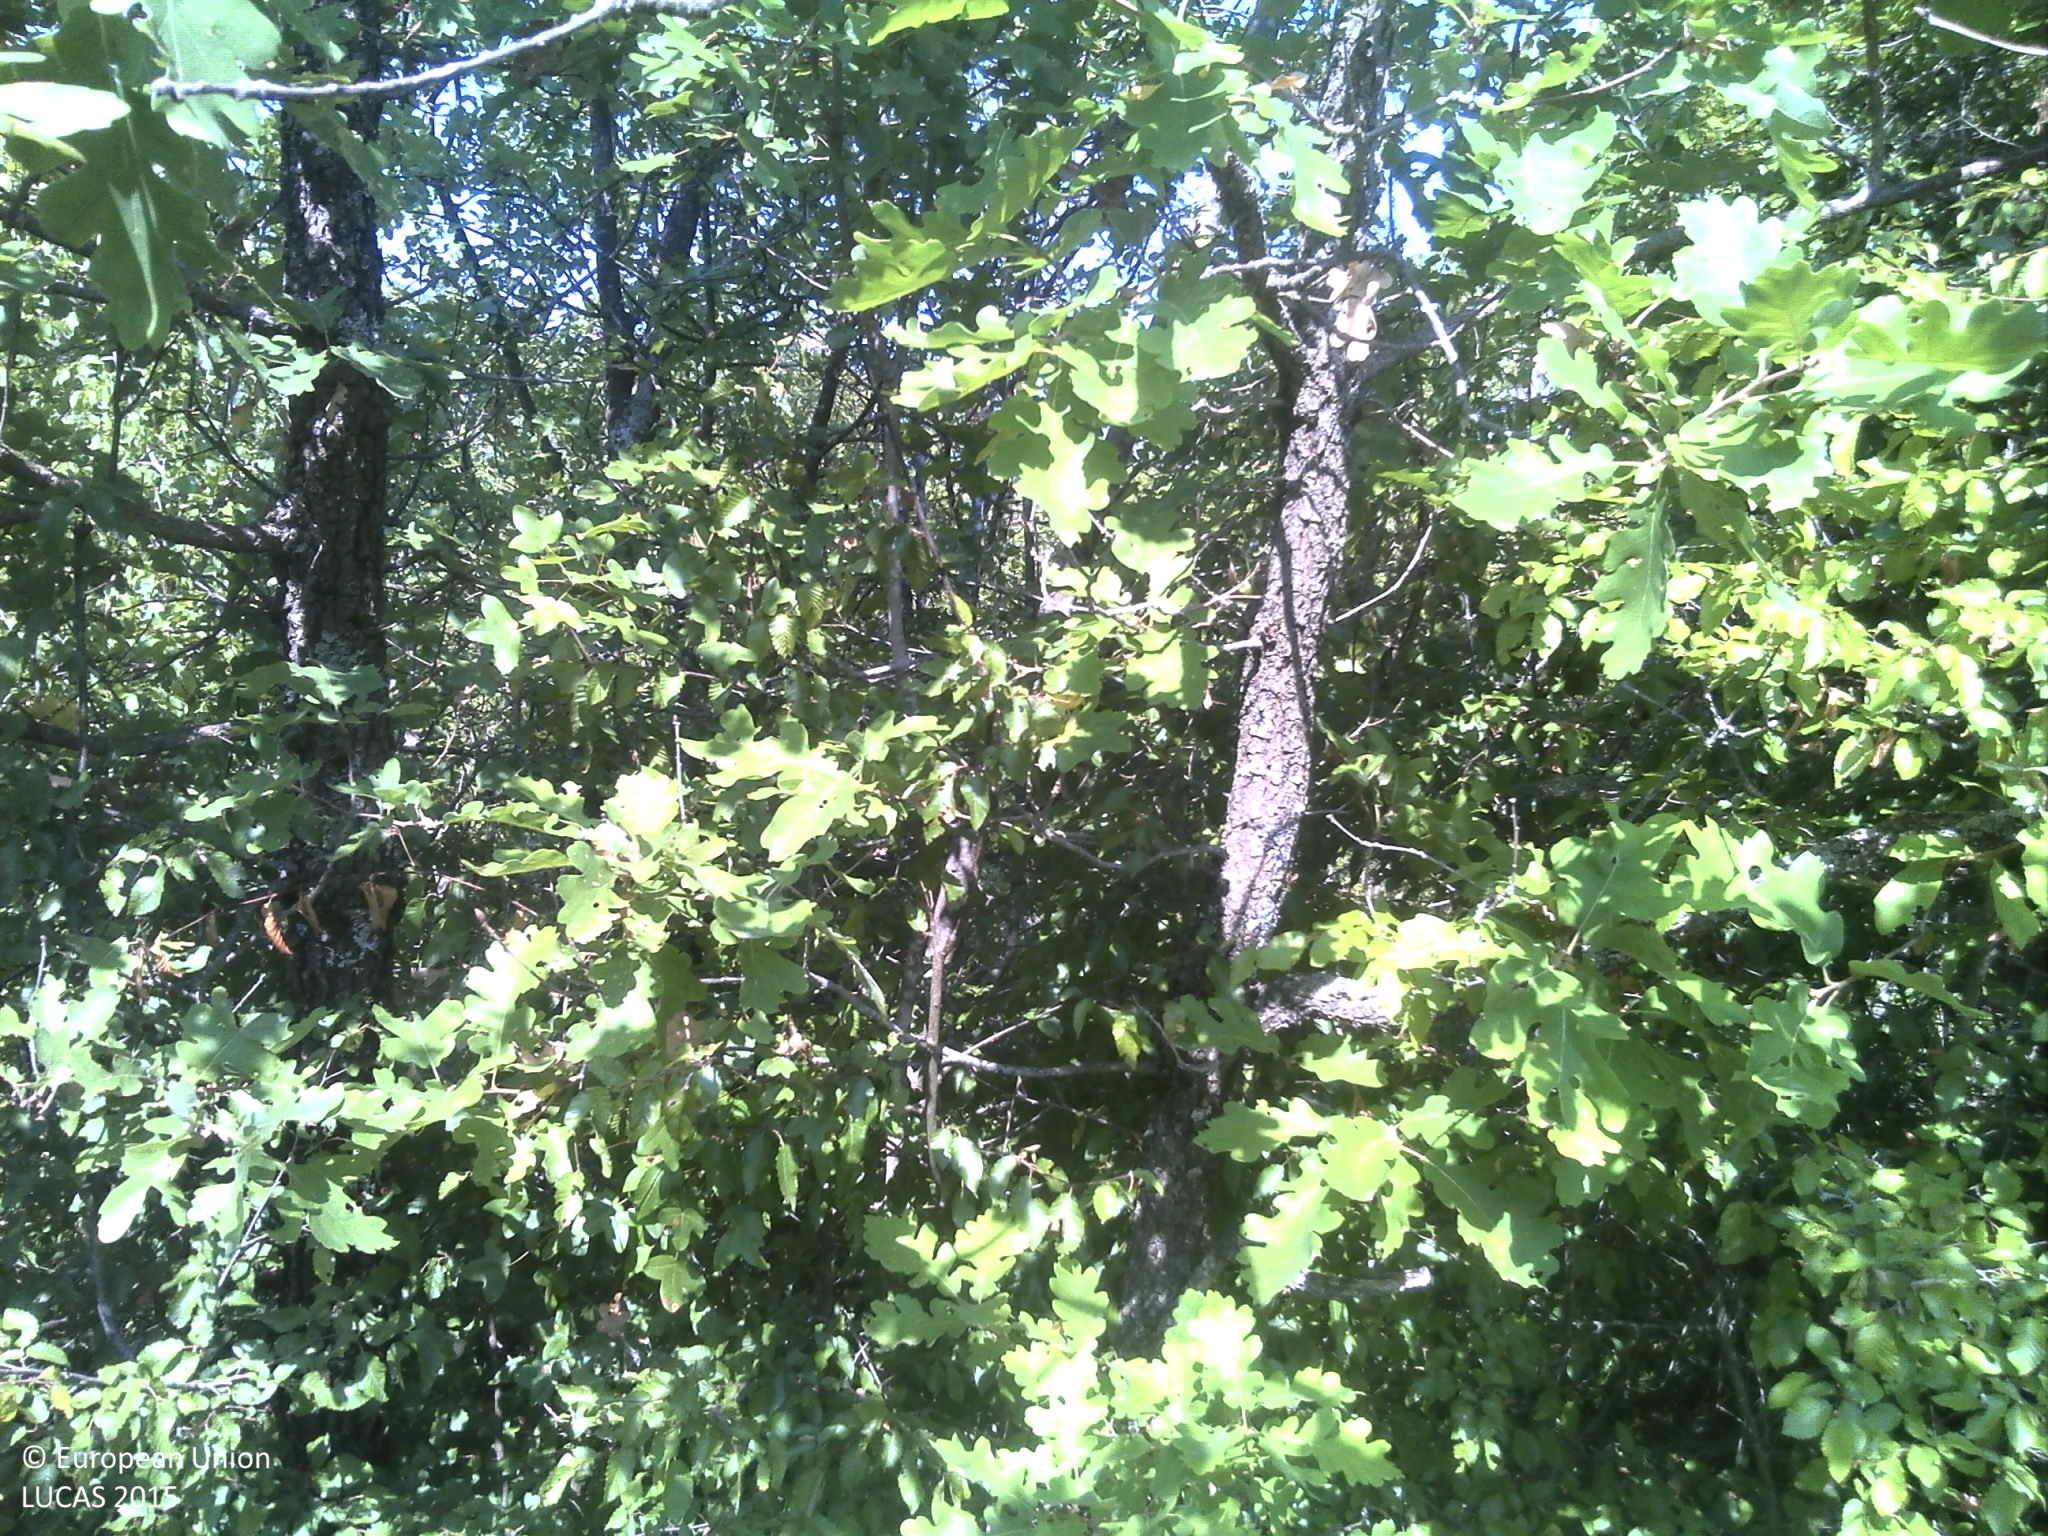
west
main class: Woodland
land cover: Broadleaved woodland
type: thermophilous deciduous forest
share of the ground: > 75 %
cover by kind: broadleaved forest trees 50 %, shrubs 35 %, herbaceous plants 10 %, consolidated bare surface 5 %
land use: Semi-natural and natural areas not in use
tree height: > 5 m
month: July
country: HR
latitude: 43.3537
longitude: 17.2585
